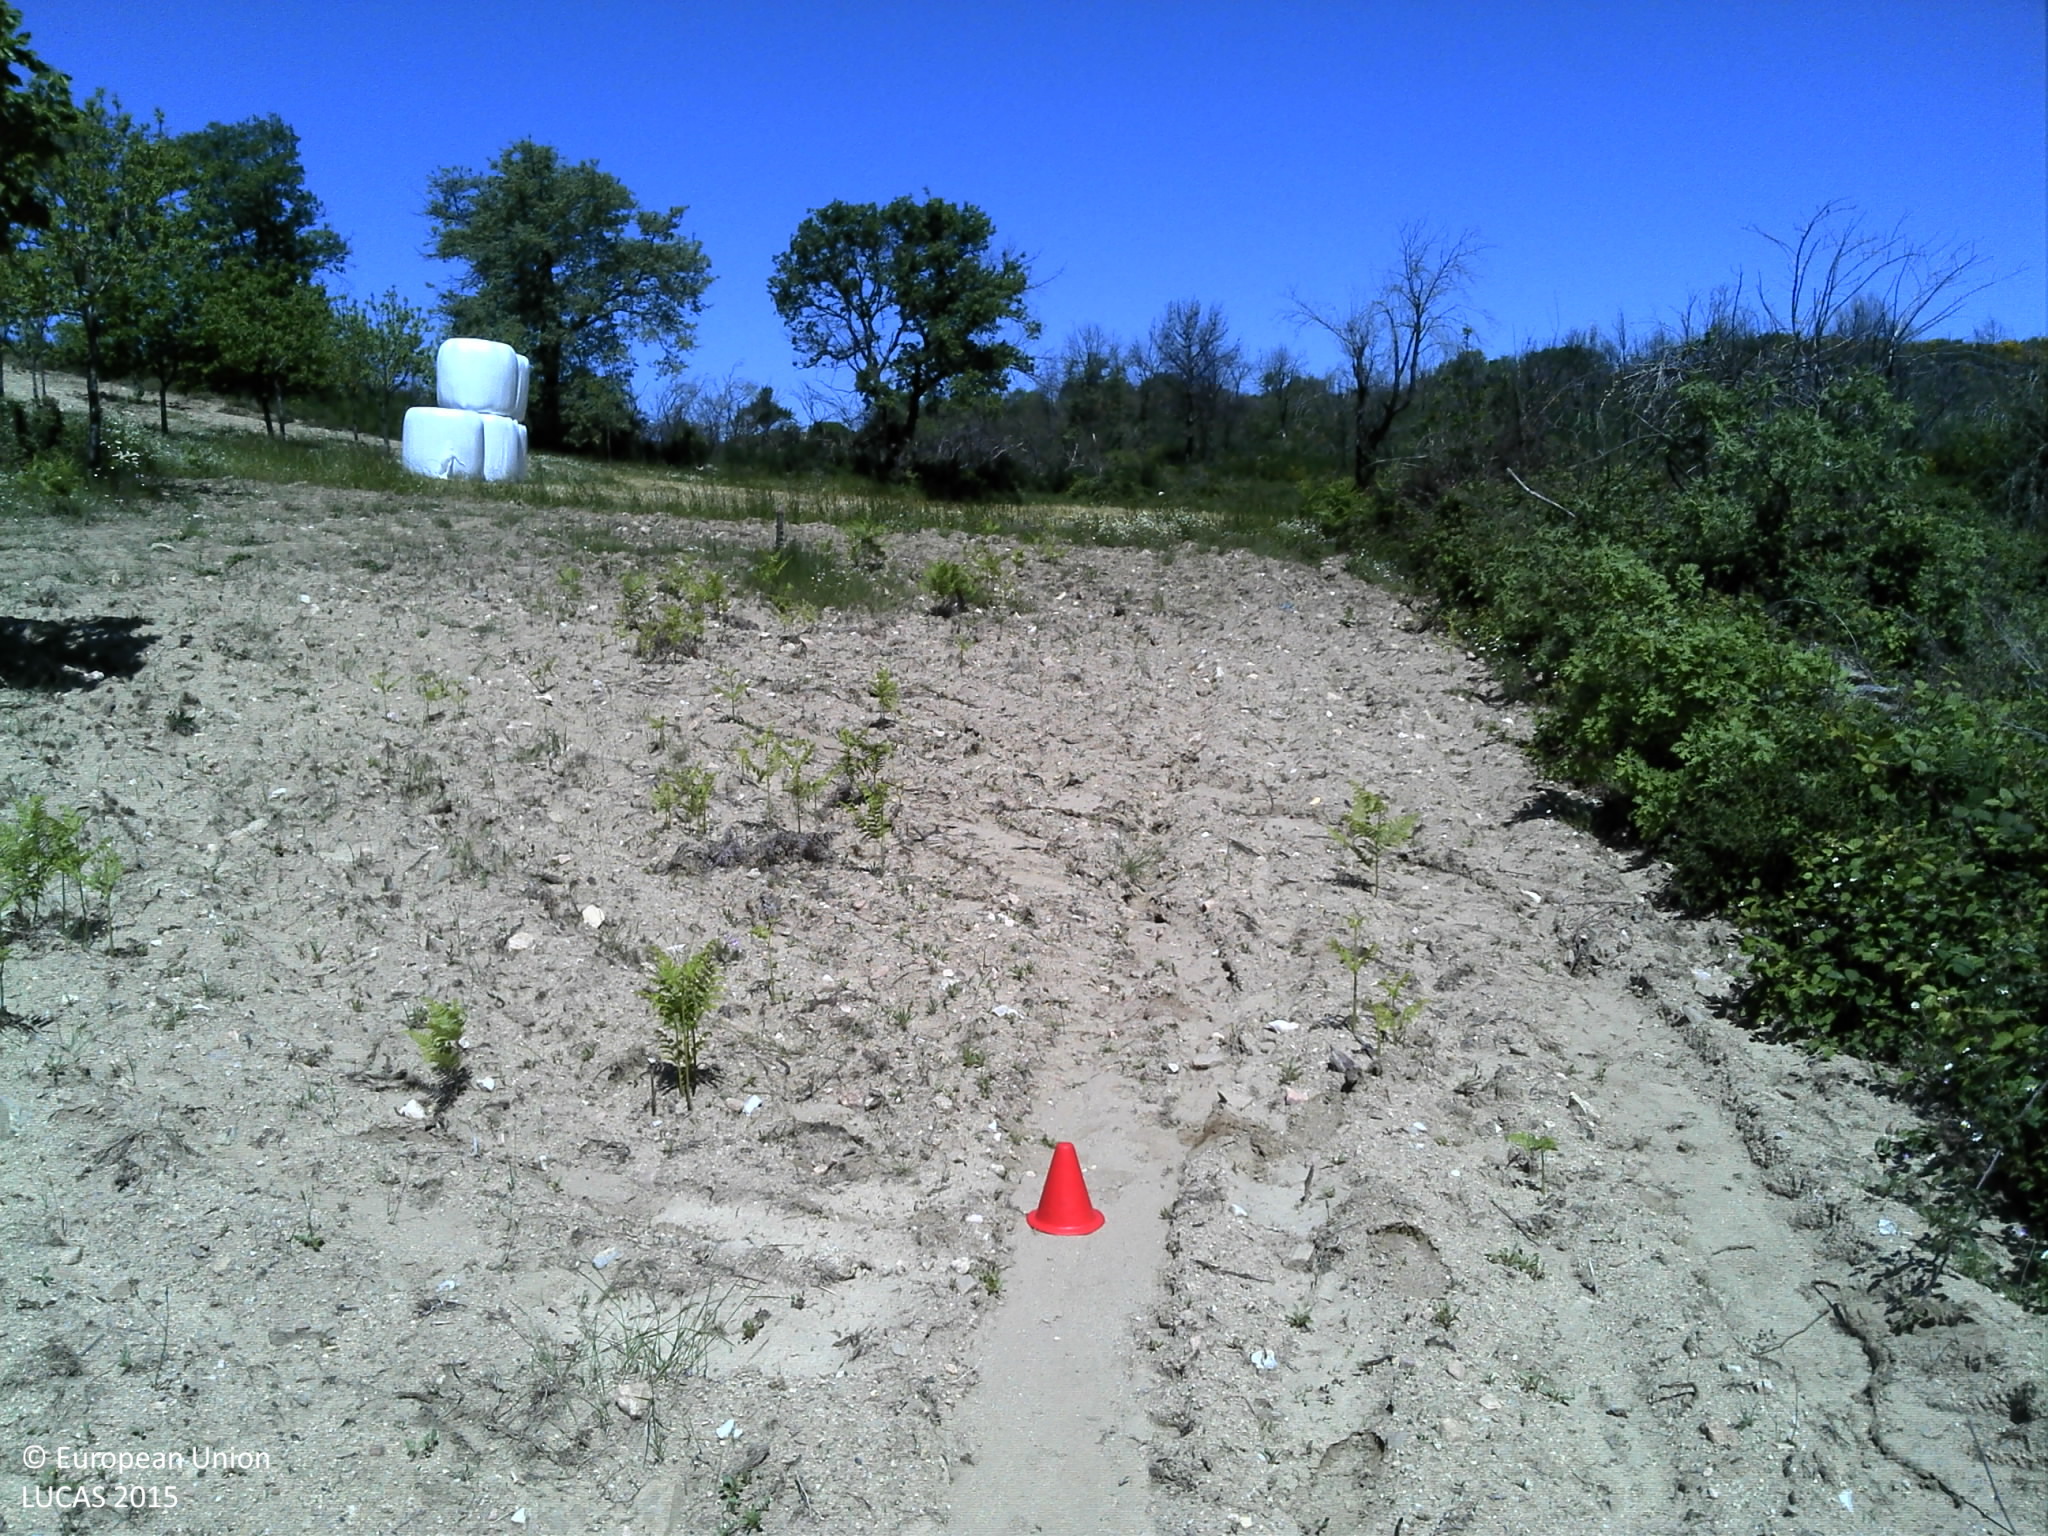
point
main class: Cropland
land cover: Nuts trees
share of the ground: < 10 %
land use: Agriculture (excluding fallow land and kitchen gardens)
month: May
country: PT
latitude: 41.7361
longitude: -7.3317
